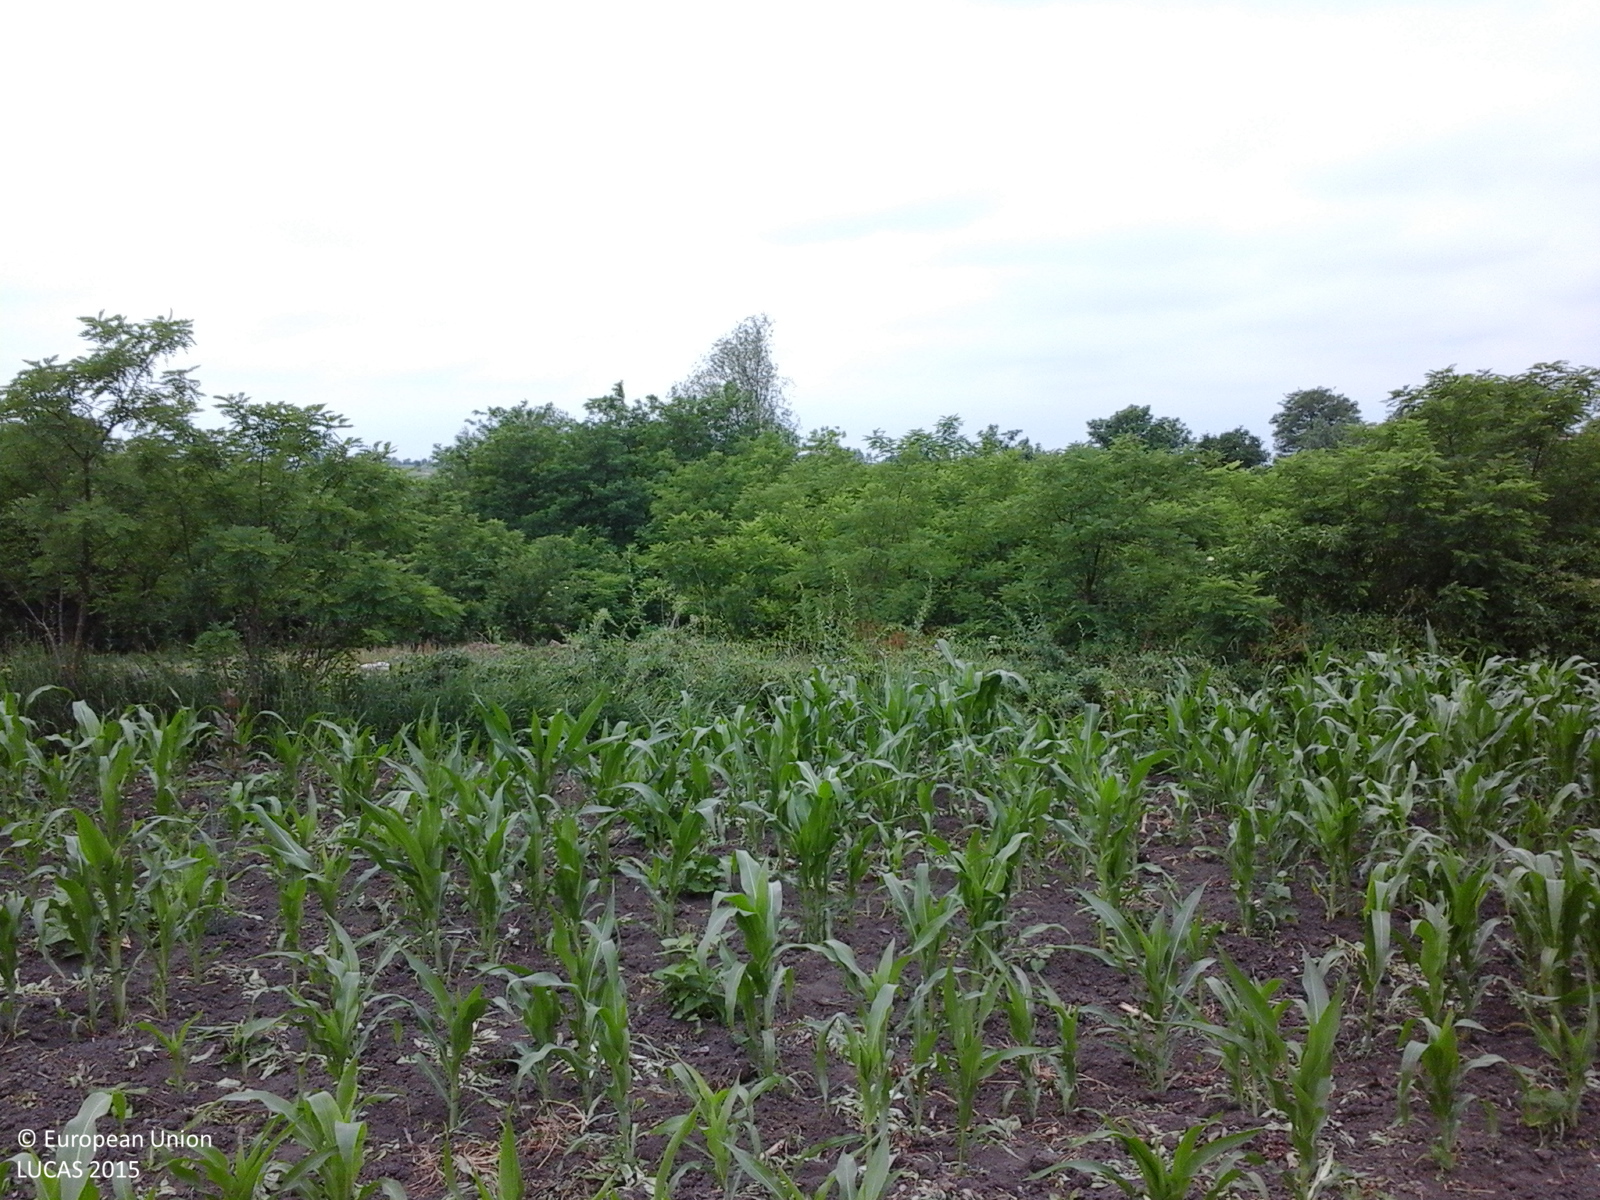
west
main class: Cropland
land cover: Maize
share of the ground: 25 - 50 %
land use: Agriculture (excluding fallow land and kitchen gardens)
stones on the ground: < 10 %
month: June
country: RO
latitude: 47.9608
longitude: 26.4975
